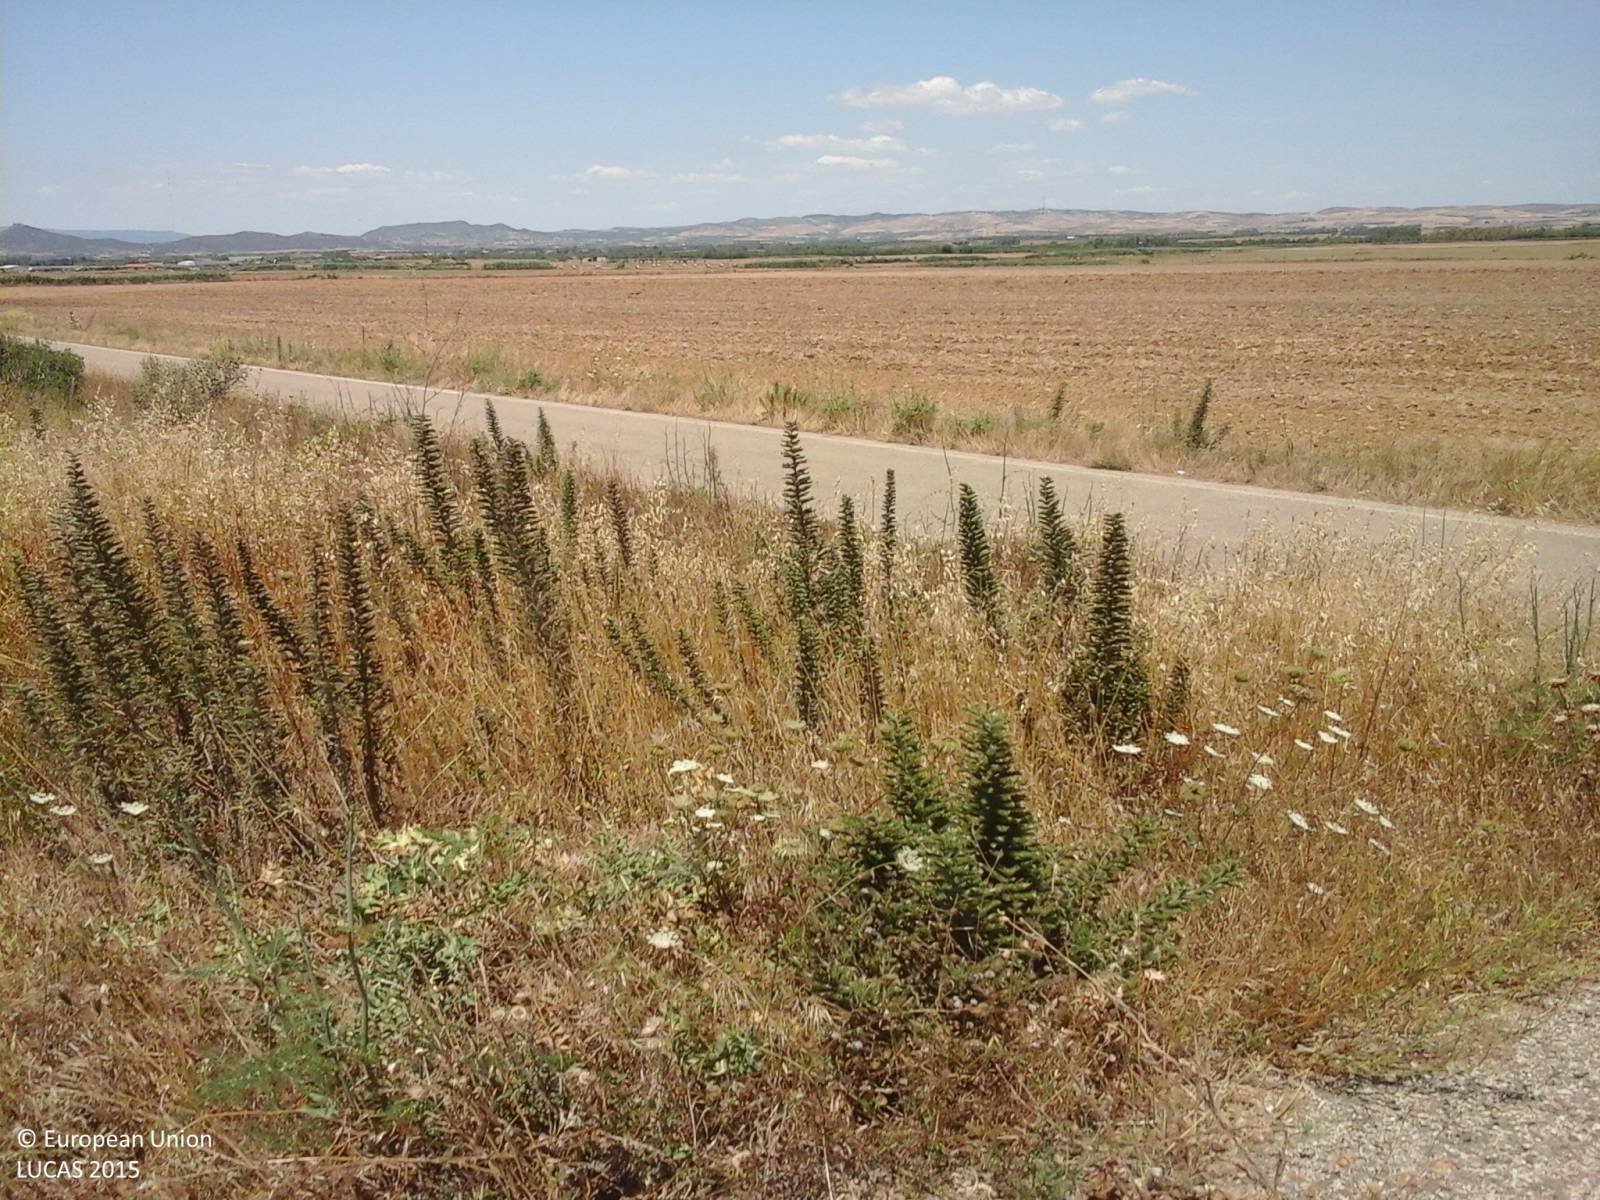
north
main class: Cropland
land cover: Maize
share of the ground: > 75 %
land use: Agriculture (excluding fallow land and kitchen gardens)
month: June
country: IT
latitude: 39.5175
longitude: 8.8090
